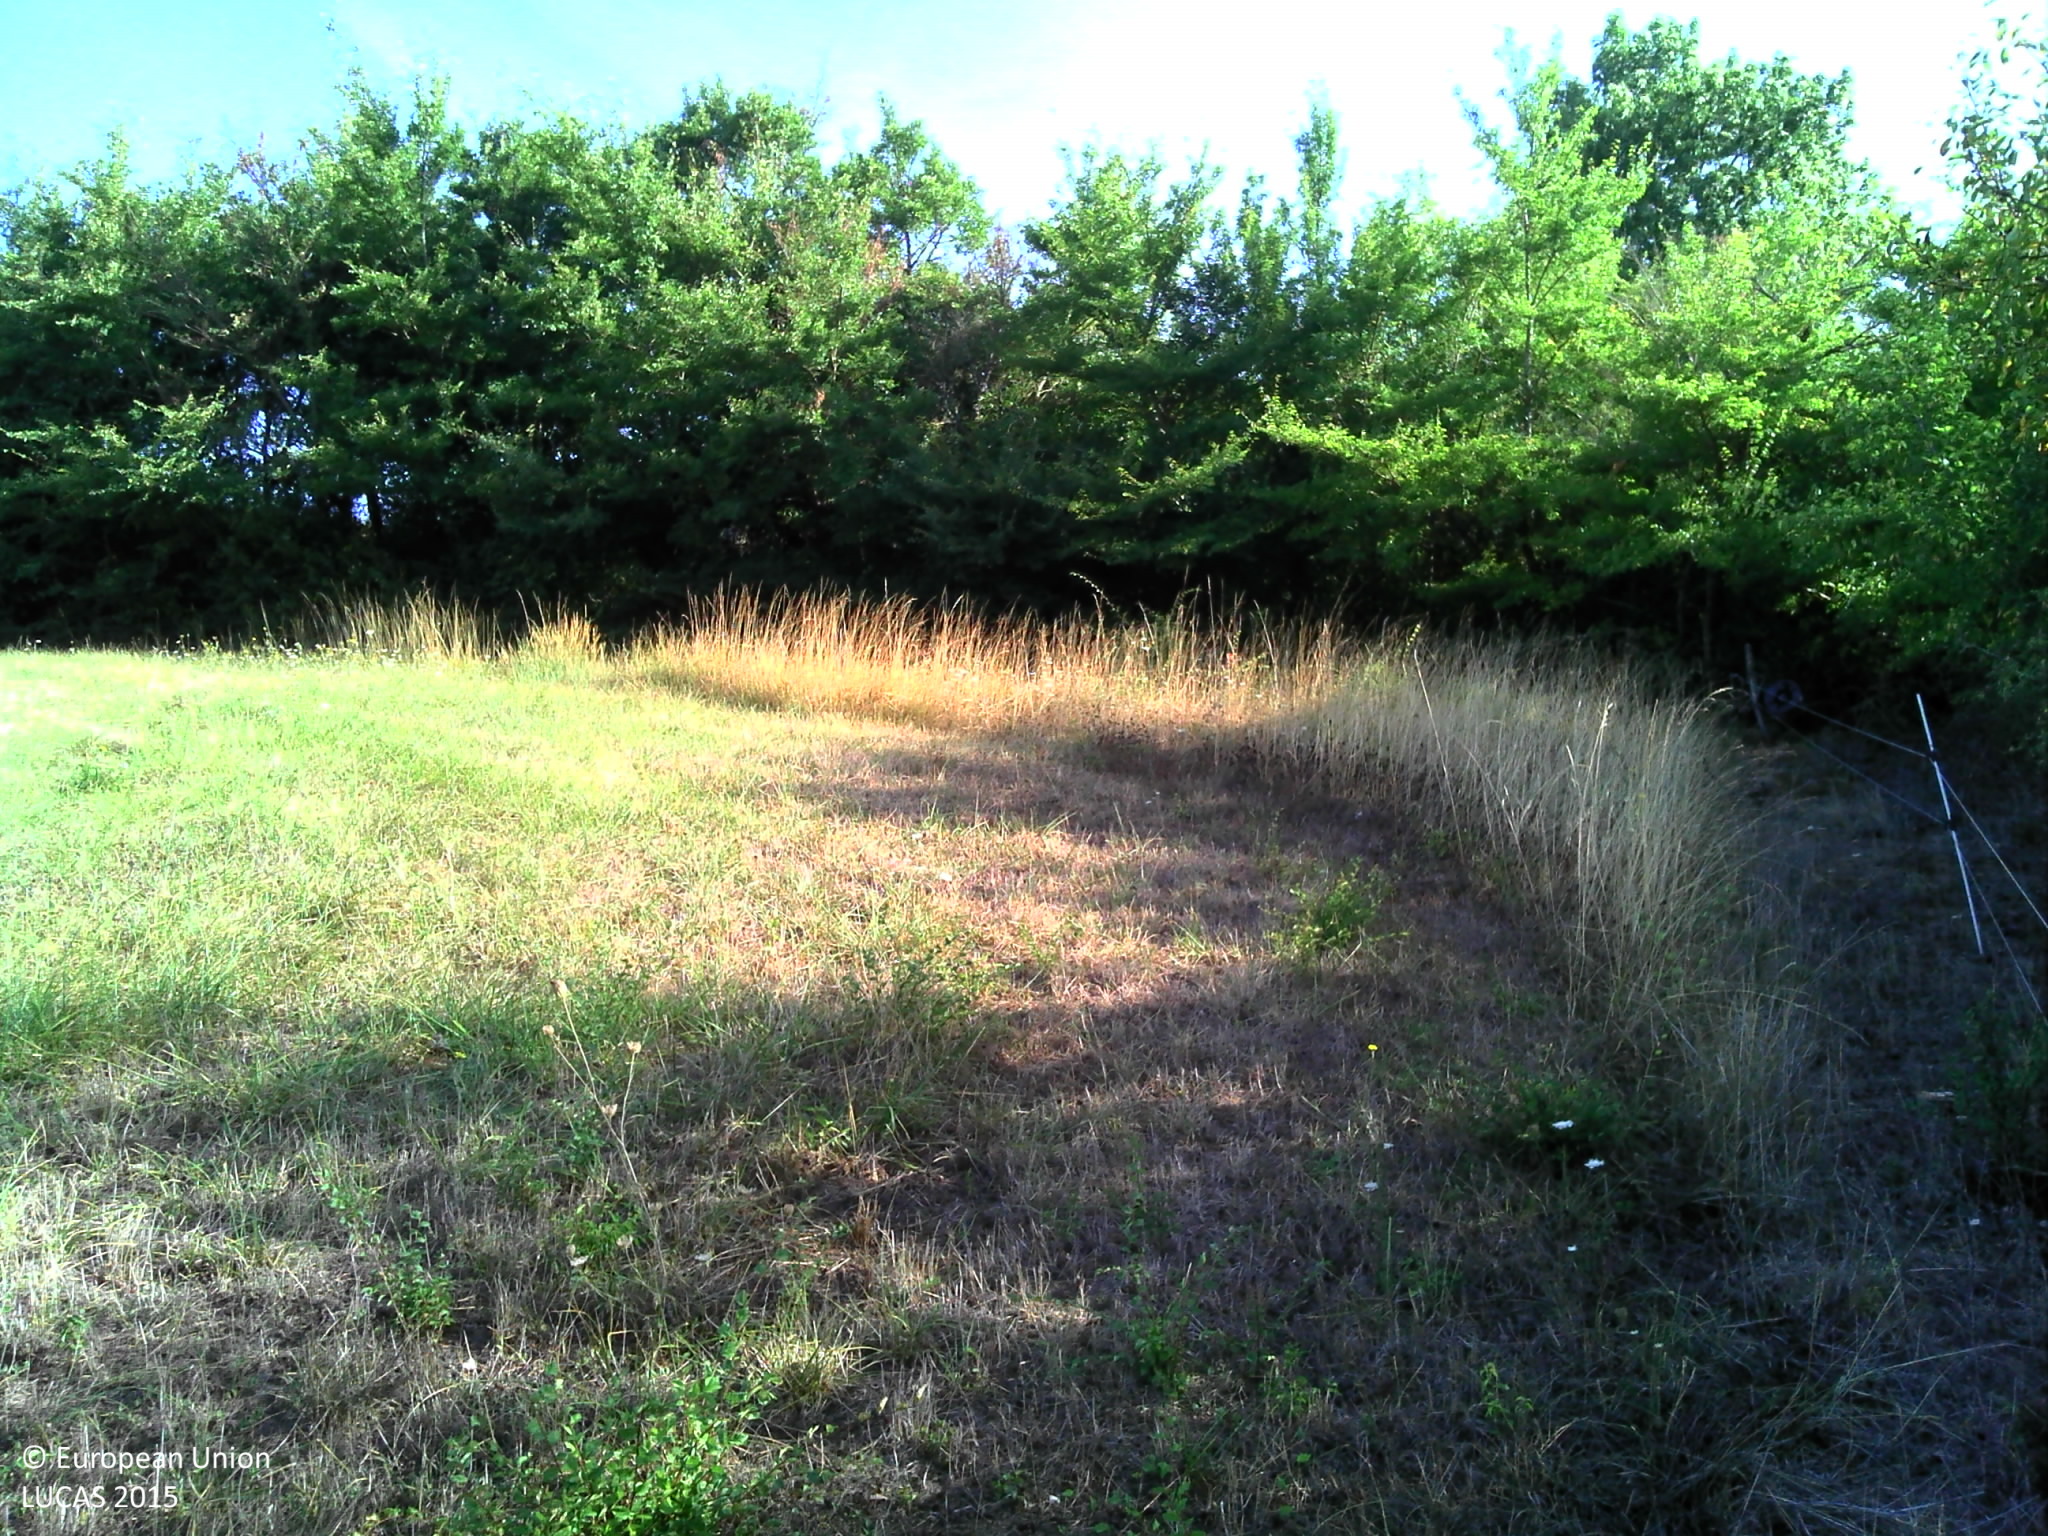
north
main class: Woodland
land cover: Broadleaved woodland
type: mesophytic deciduous forest
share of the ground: > 75 %
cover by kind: broadleaved forest trees 100 %
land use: Forestry
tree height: > 5 m
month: August
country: FR
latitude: 43.9034
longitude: 3.0966
